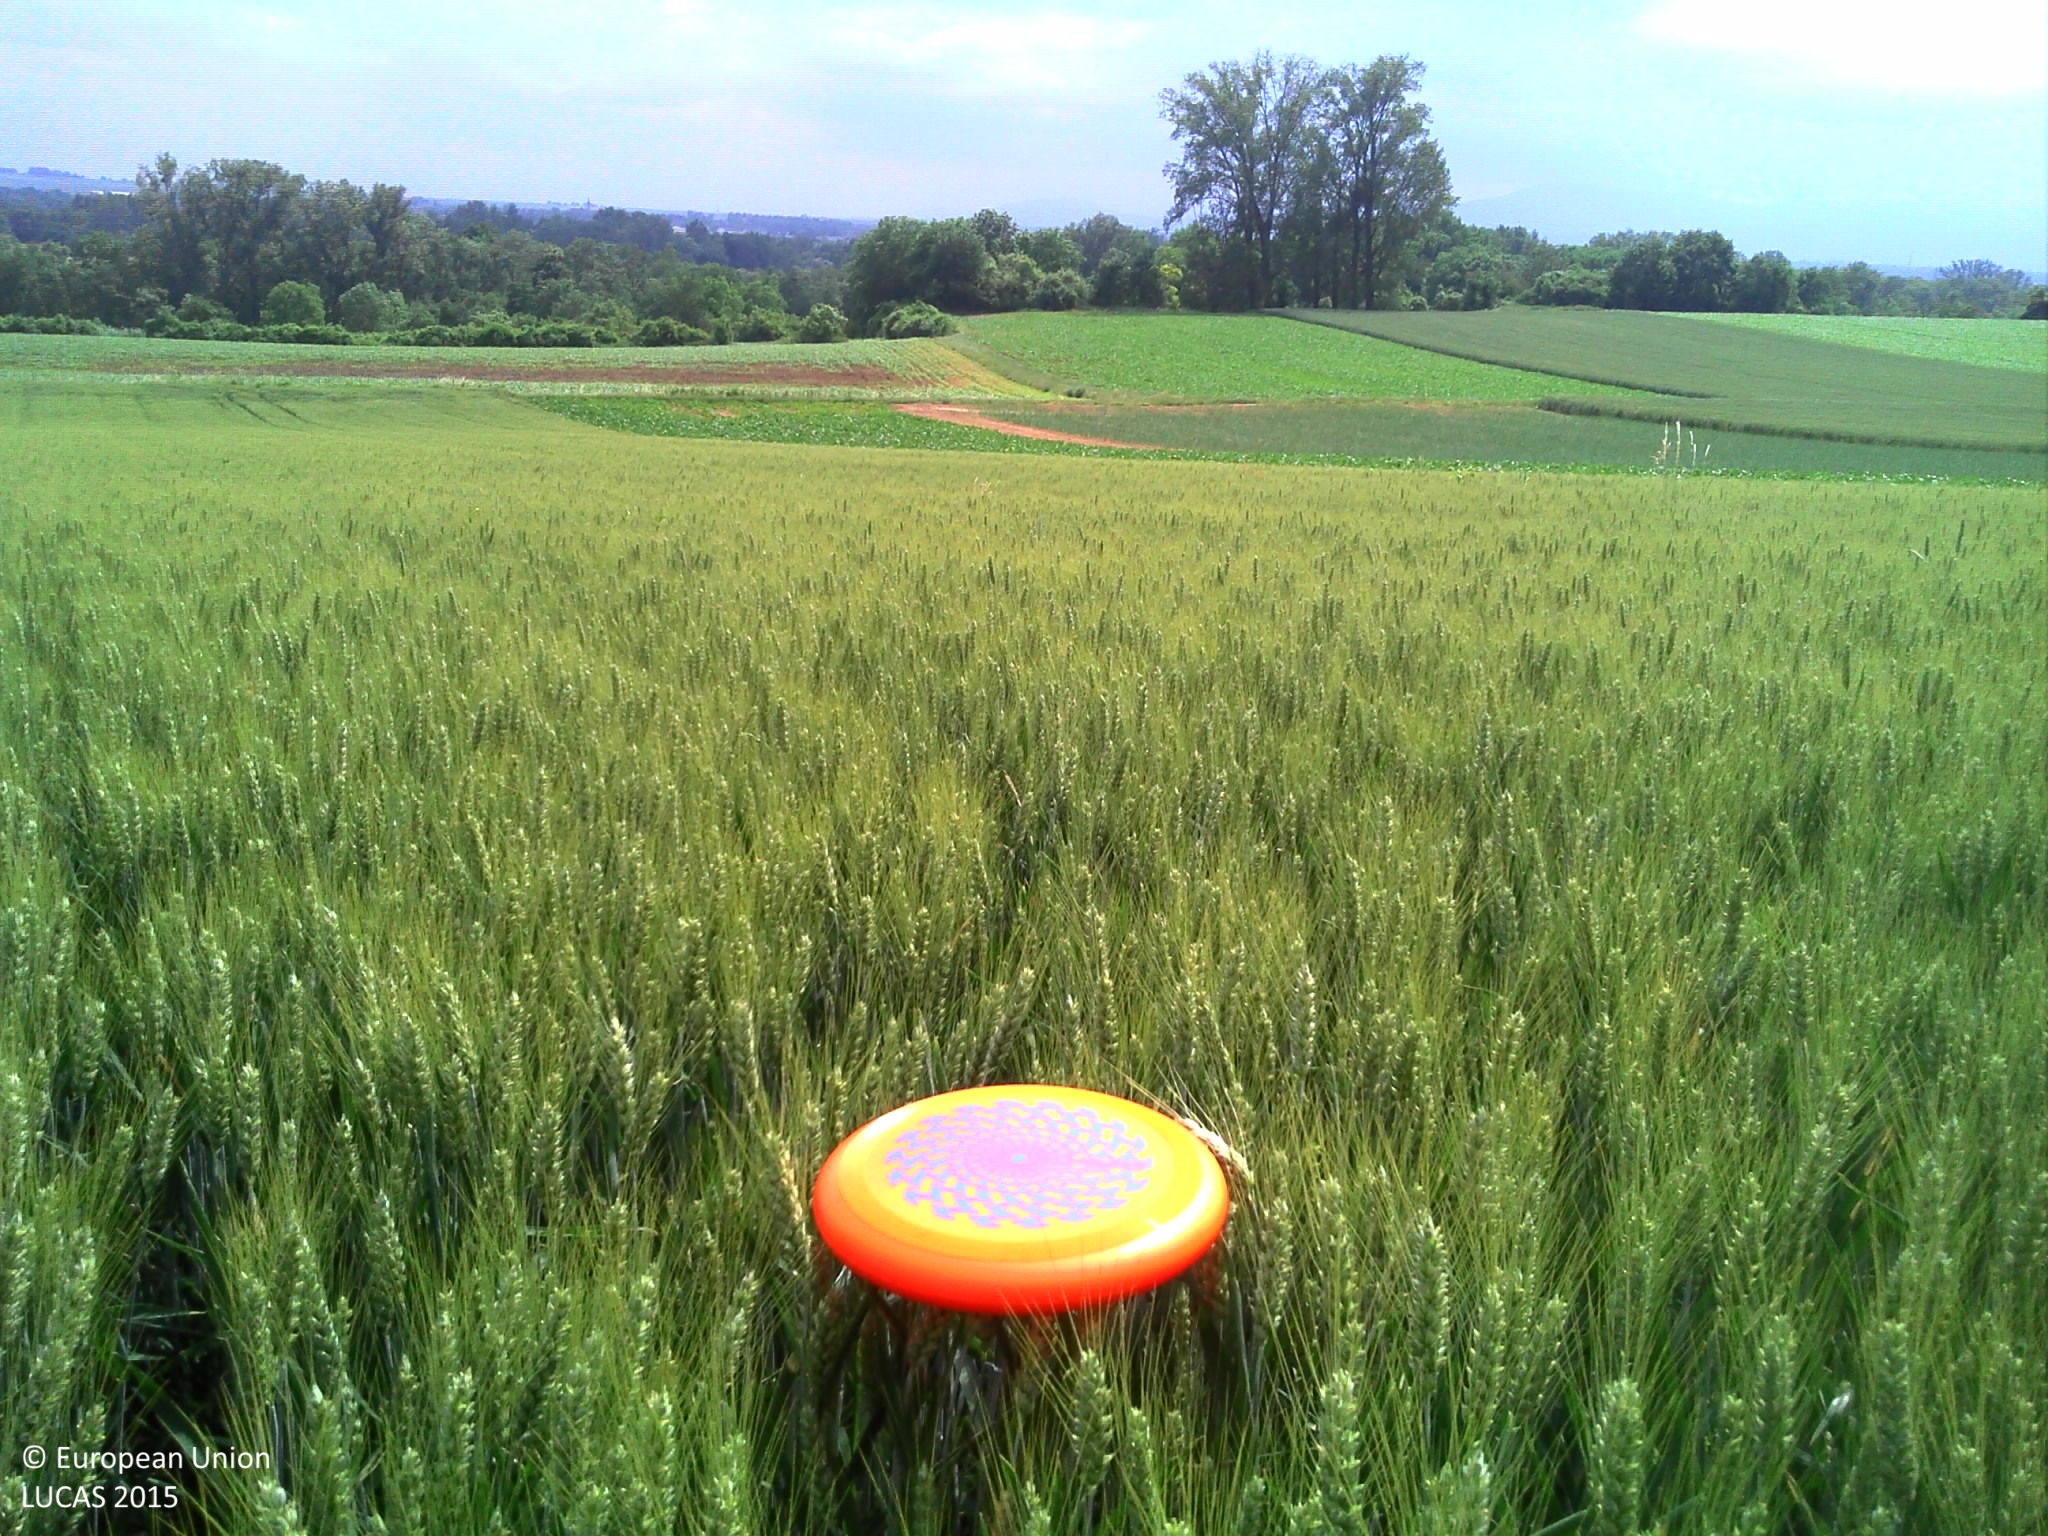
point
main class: Cropland
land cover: Common wheat
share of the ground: > 75 %
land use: Agriculture (excluding fallow land and kitchen gardens)
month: June
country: FR
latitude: 48.5575
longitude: 7.6026
